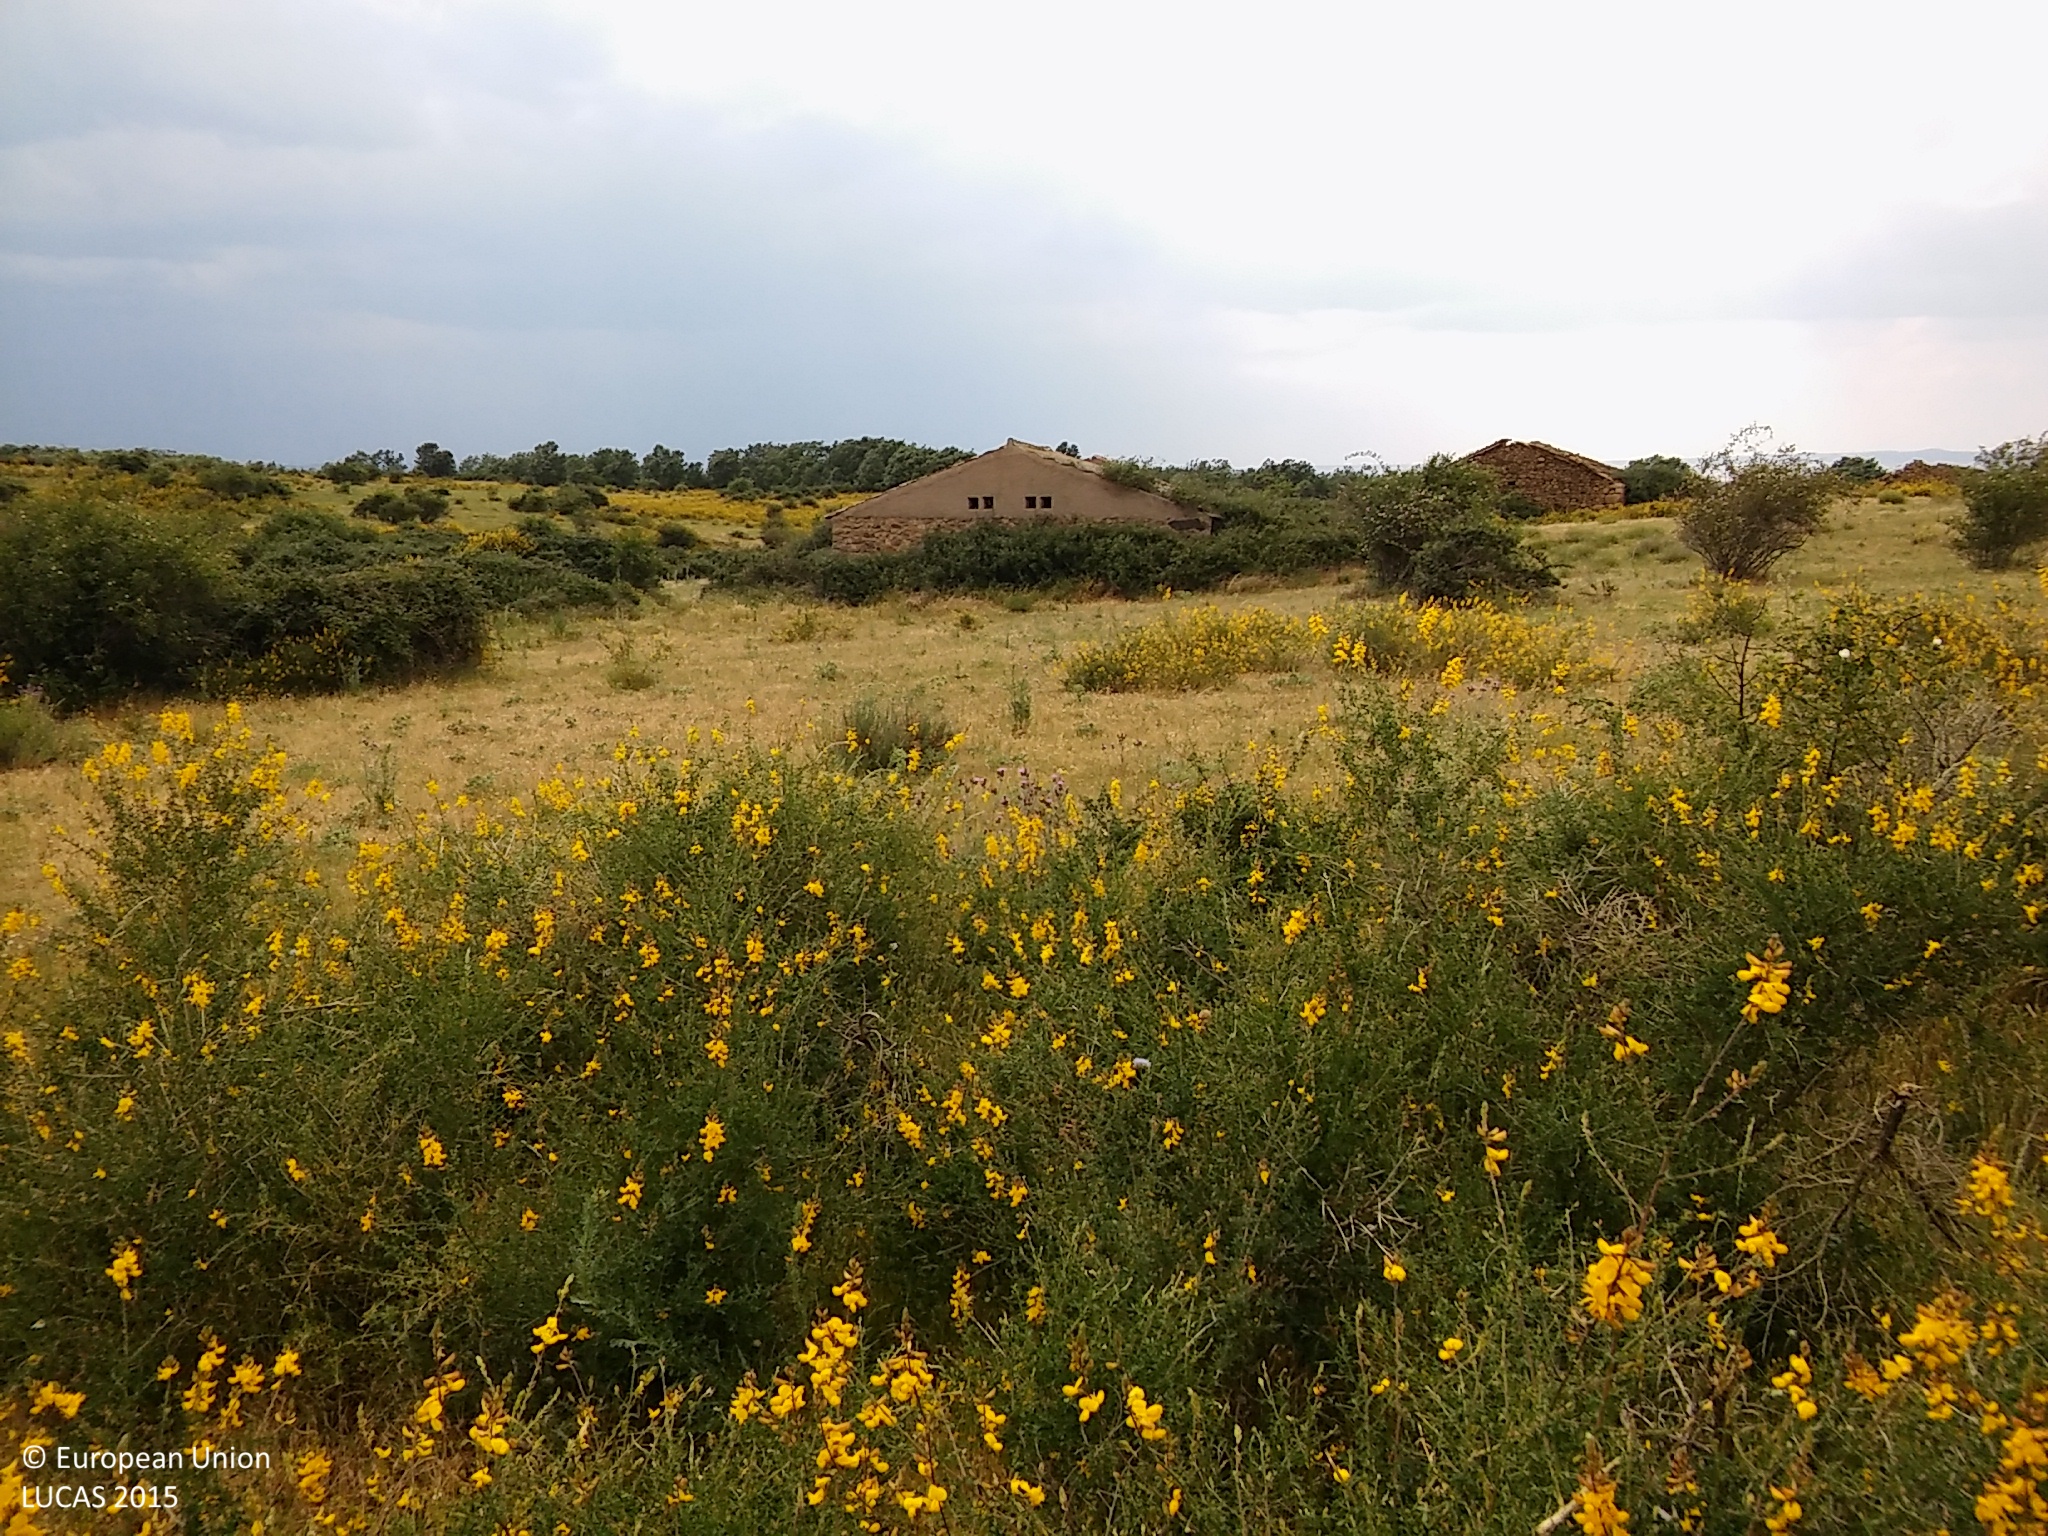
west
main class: Shrubland
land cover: Shrubland without tree cover
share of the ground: 25 - 50 %
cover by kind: herbaceous plants 70 %, shrubs 30 %
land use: Agriculture (excluding fallow land and kitchen gardens)
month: June
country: ES
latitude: 41.2105
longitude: -3.5340
